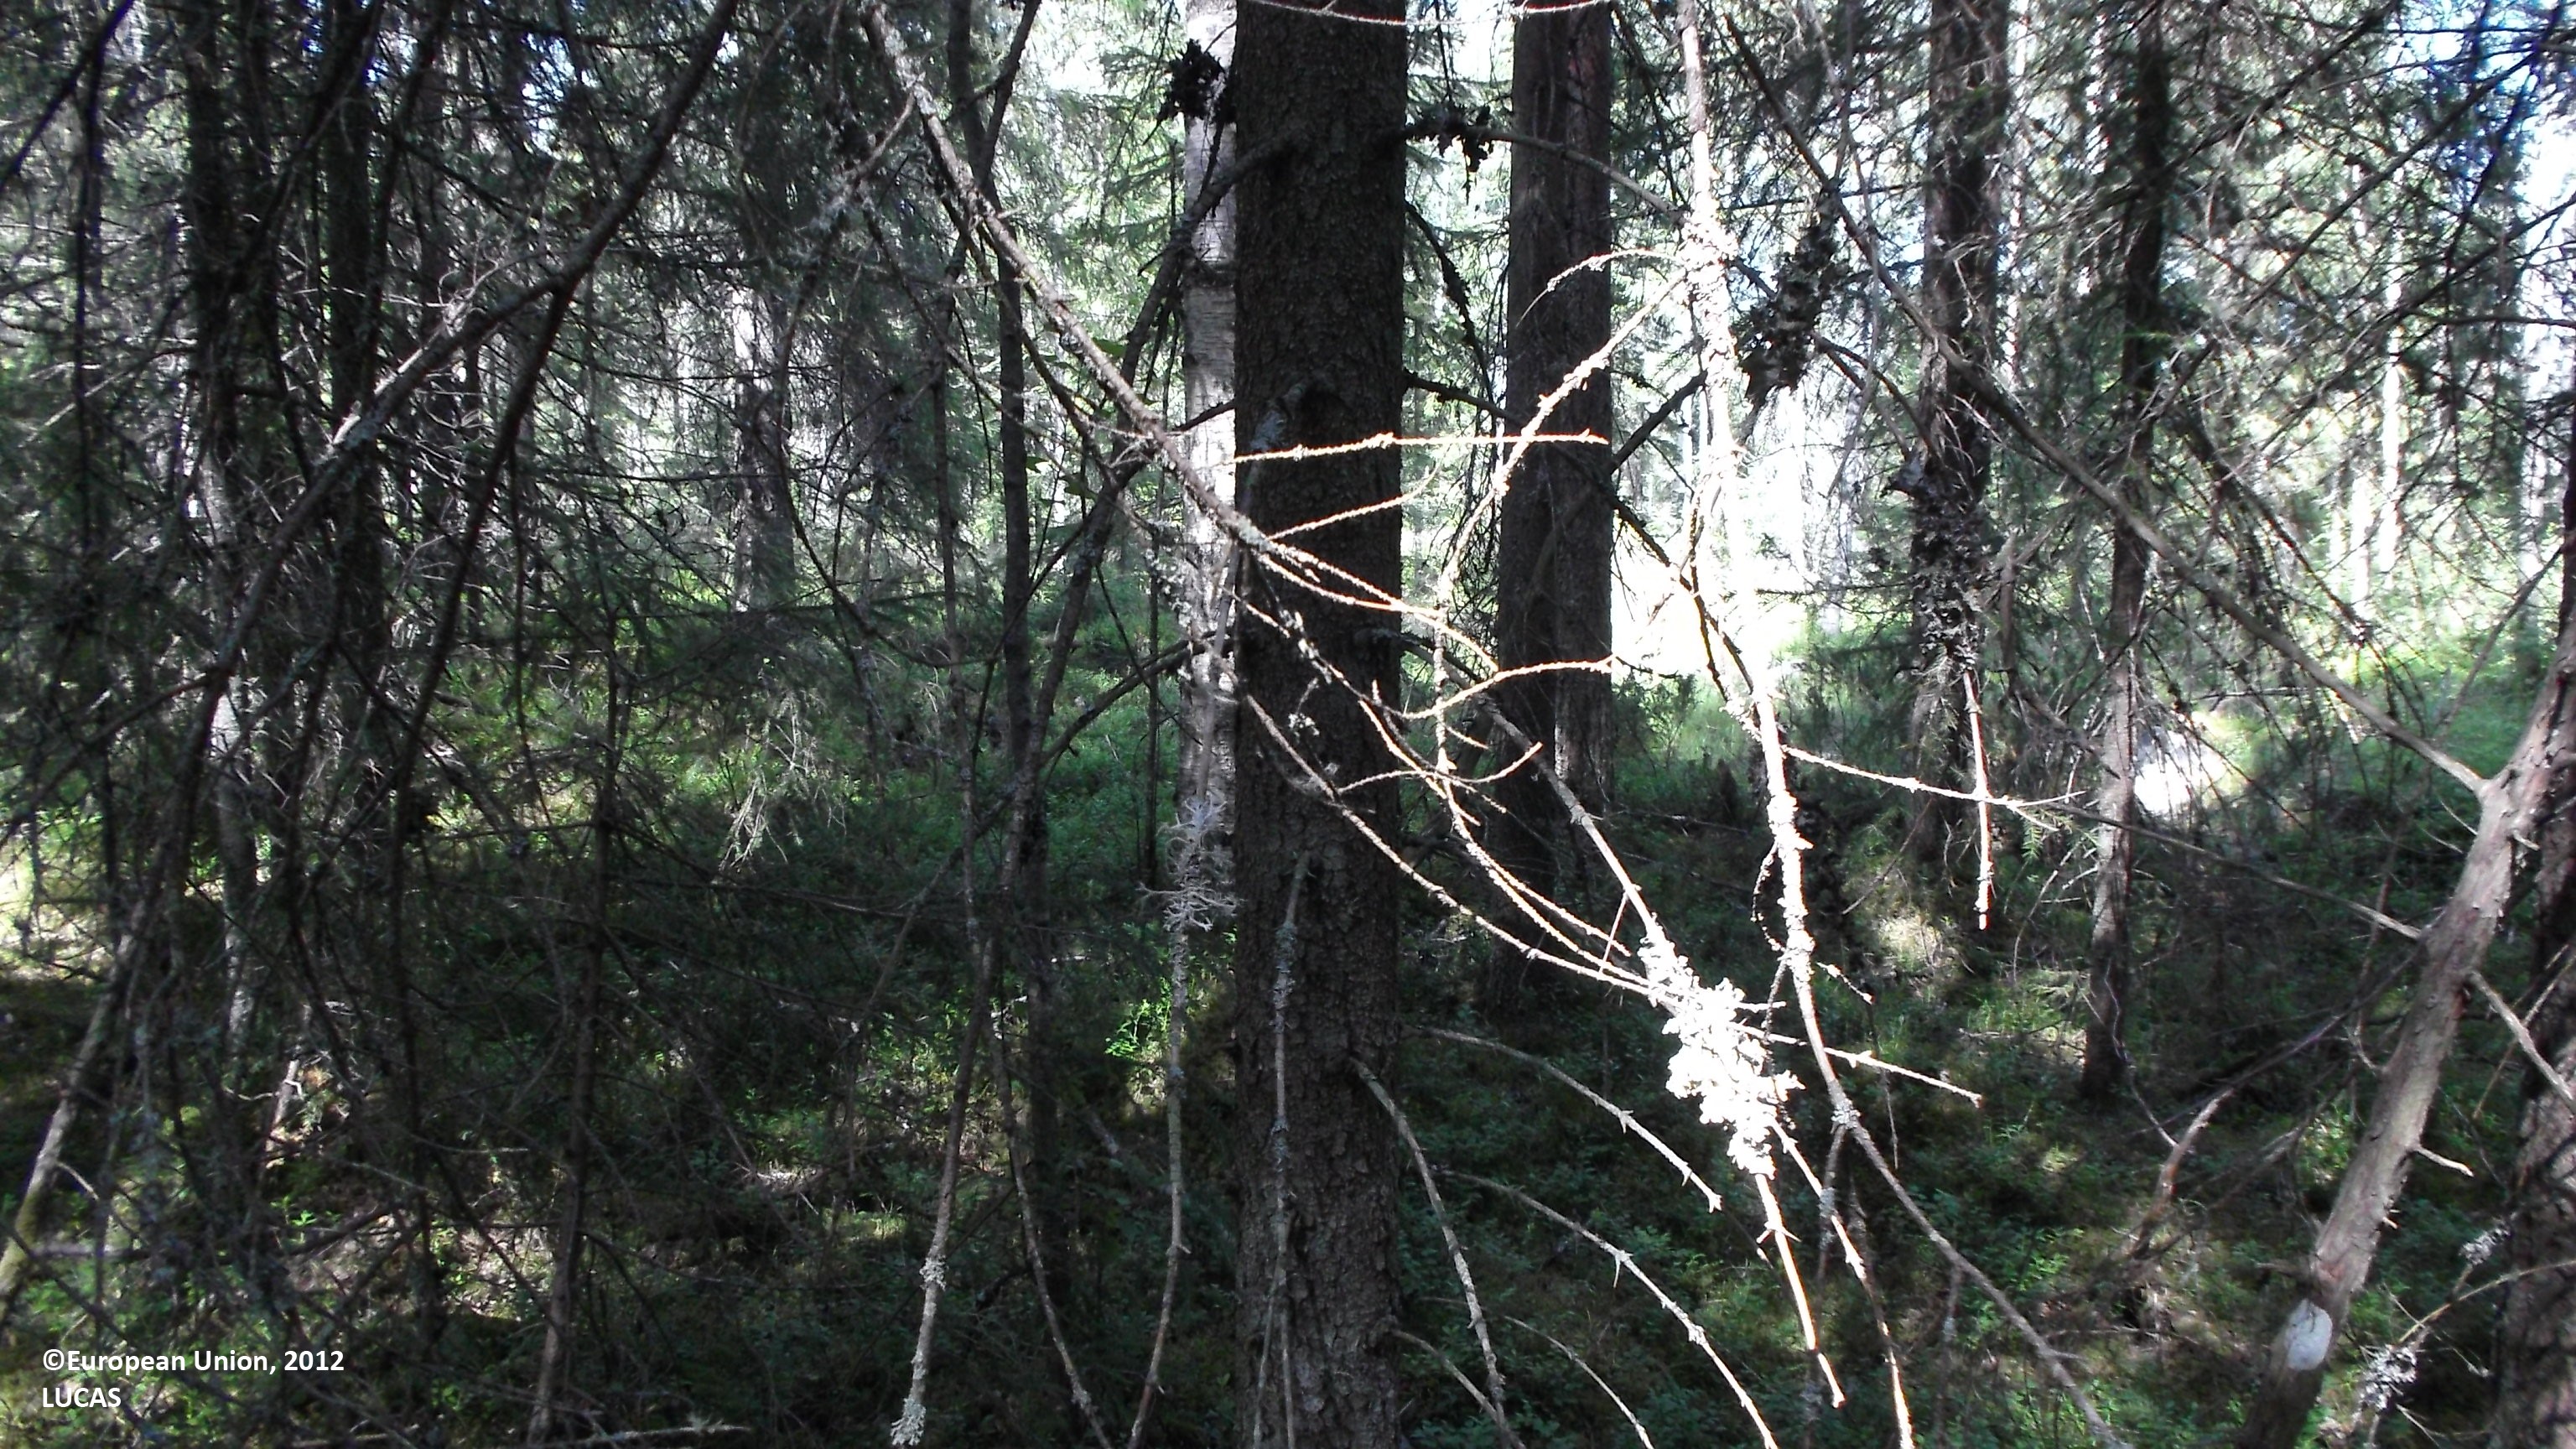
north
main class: Woodland
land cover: Spruce dominated coniferous woodland
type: boreal forest
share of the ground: > 75 %
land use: Forestry
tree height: > 5 m
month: July
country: FI
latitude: 63.6642
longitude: 23.9891
